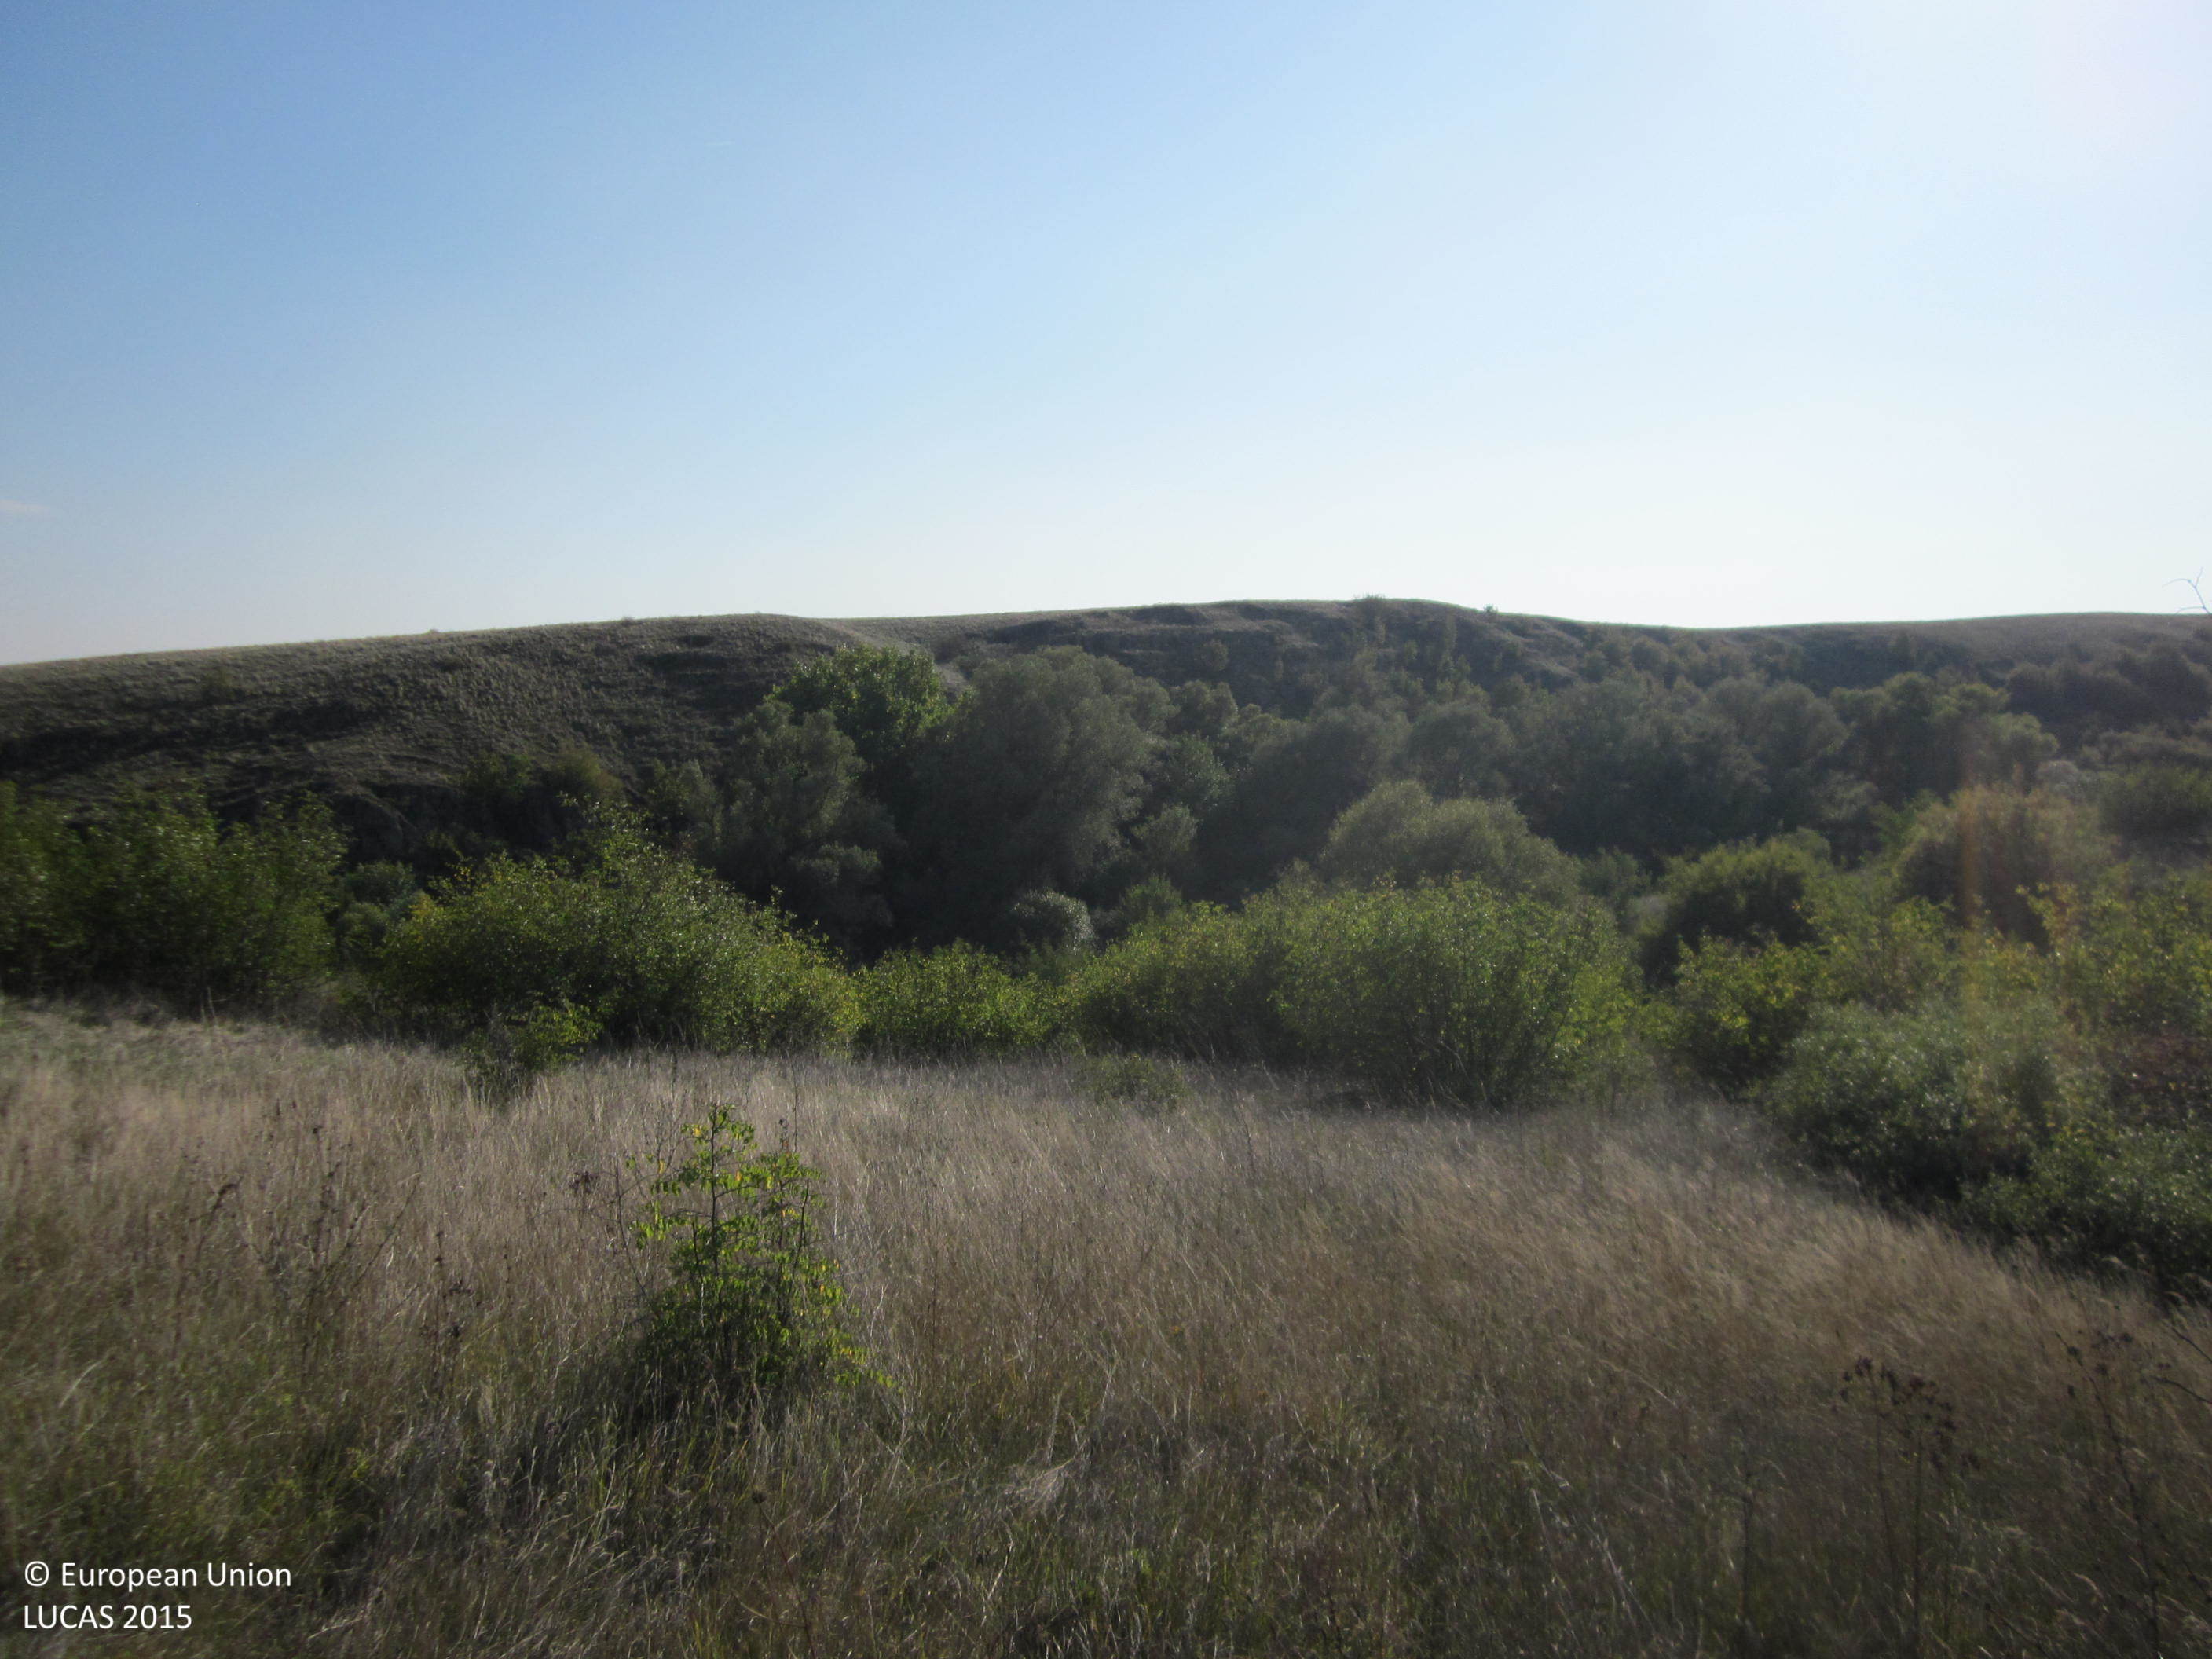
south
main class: Grassland
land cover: Grassland with sparse tree/shrub cover
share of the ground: > 75 %
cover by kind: herbaceous plants 85 %, shrubs 10 %, broadleaved forest trees 5 %
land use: Agriculture (excluding fallow land and kitchen gardens)
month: October
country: BG
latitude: 42.6518
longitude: 26.8258
